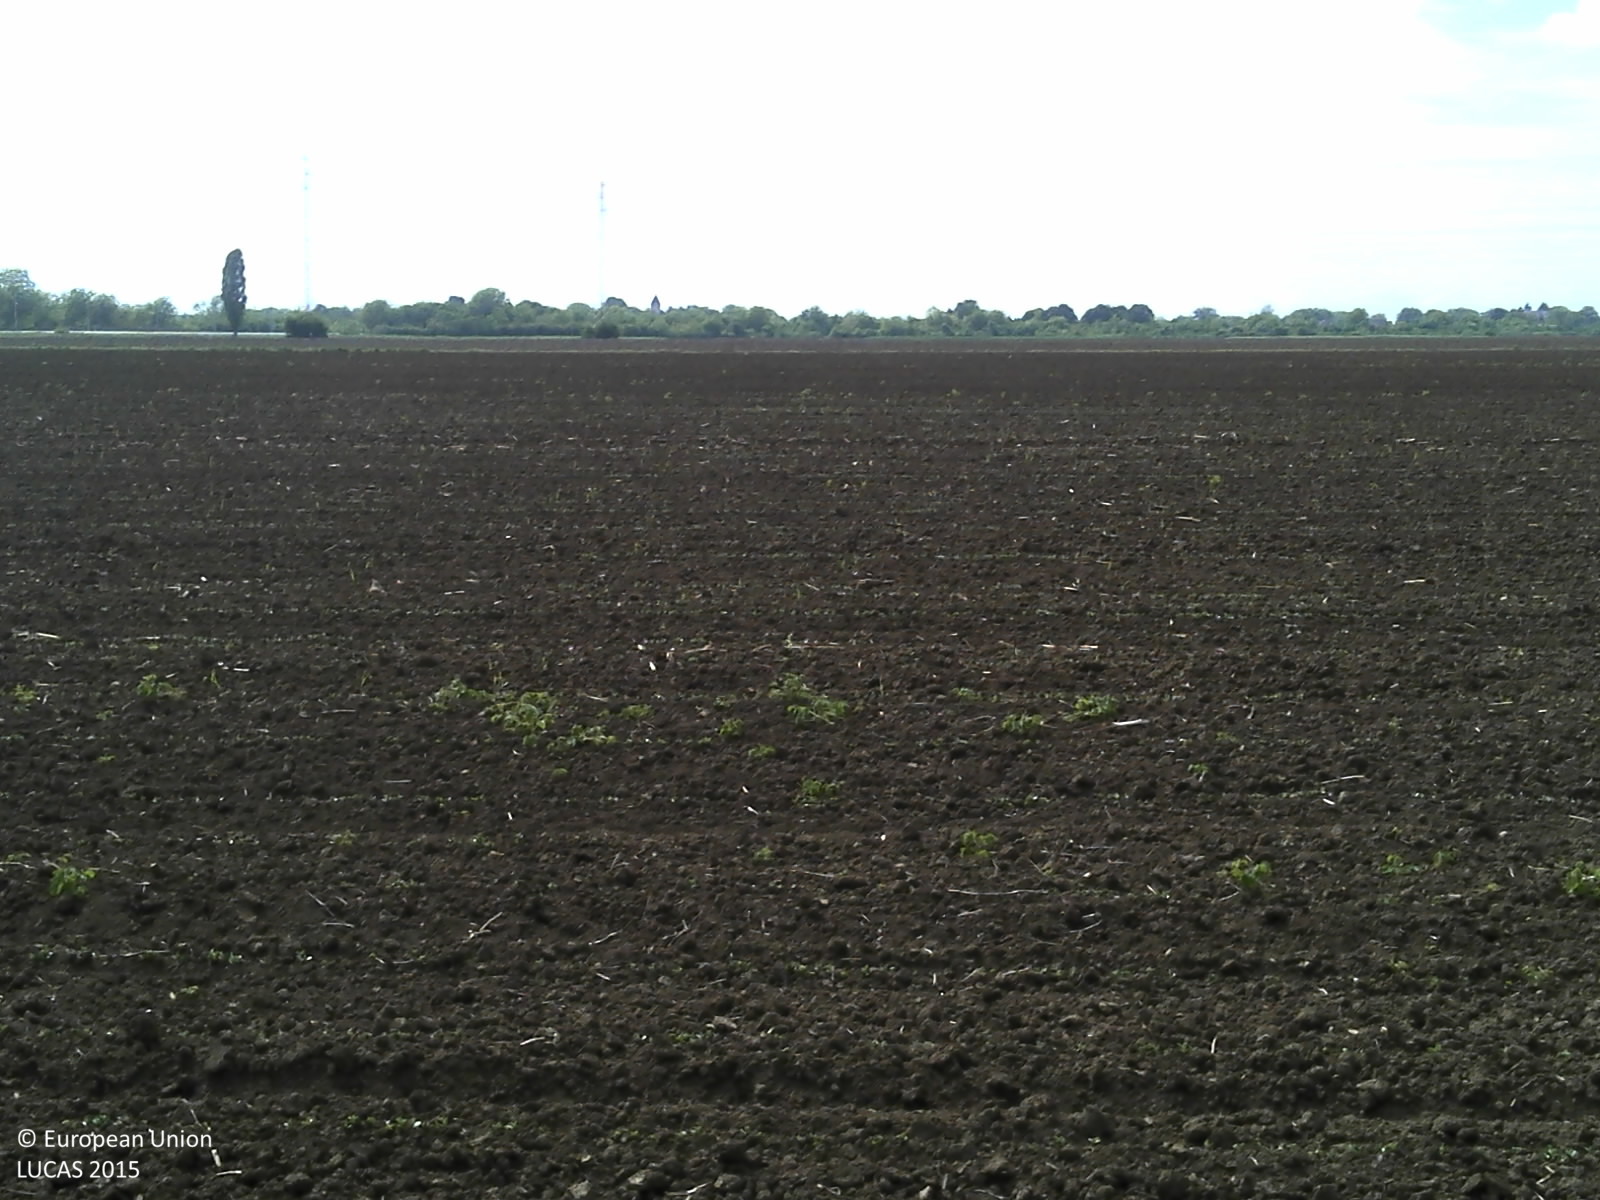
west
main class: Cropland
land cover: Soya
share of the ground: < 10 %
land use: Agriculture (excluding fallow land and kitchen gardens)
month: May
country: HR
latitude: 45.1847
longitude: 19.0827
